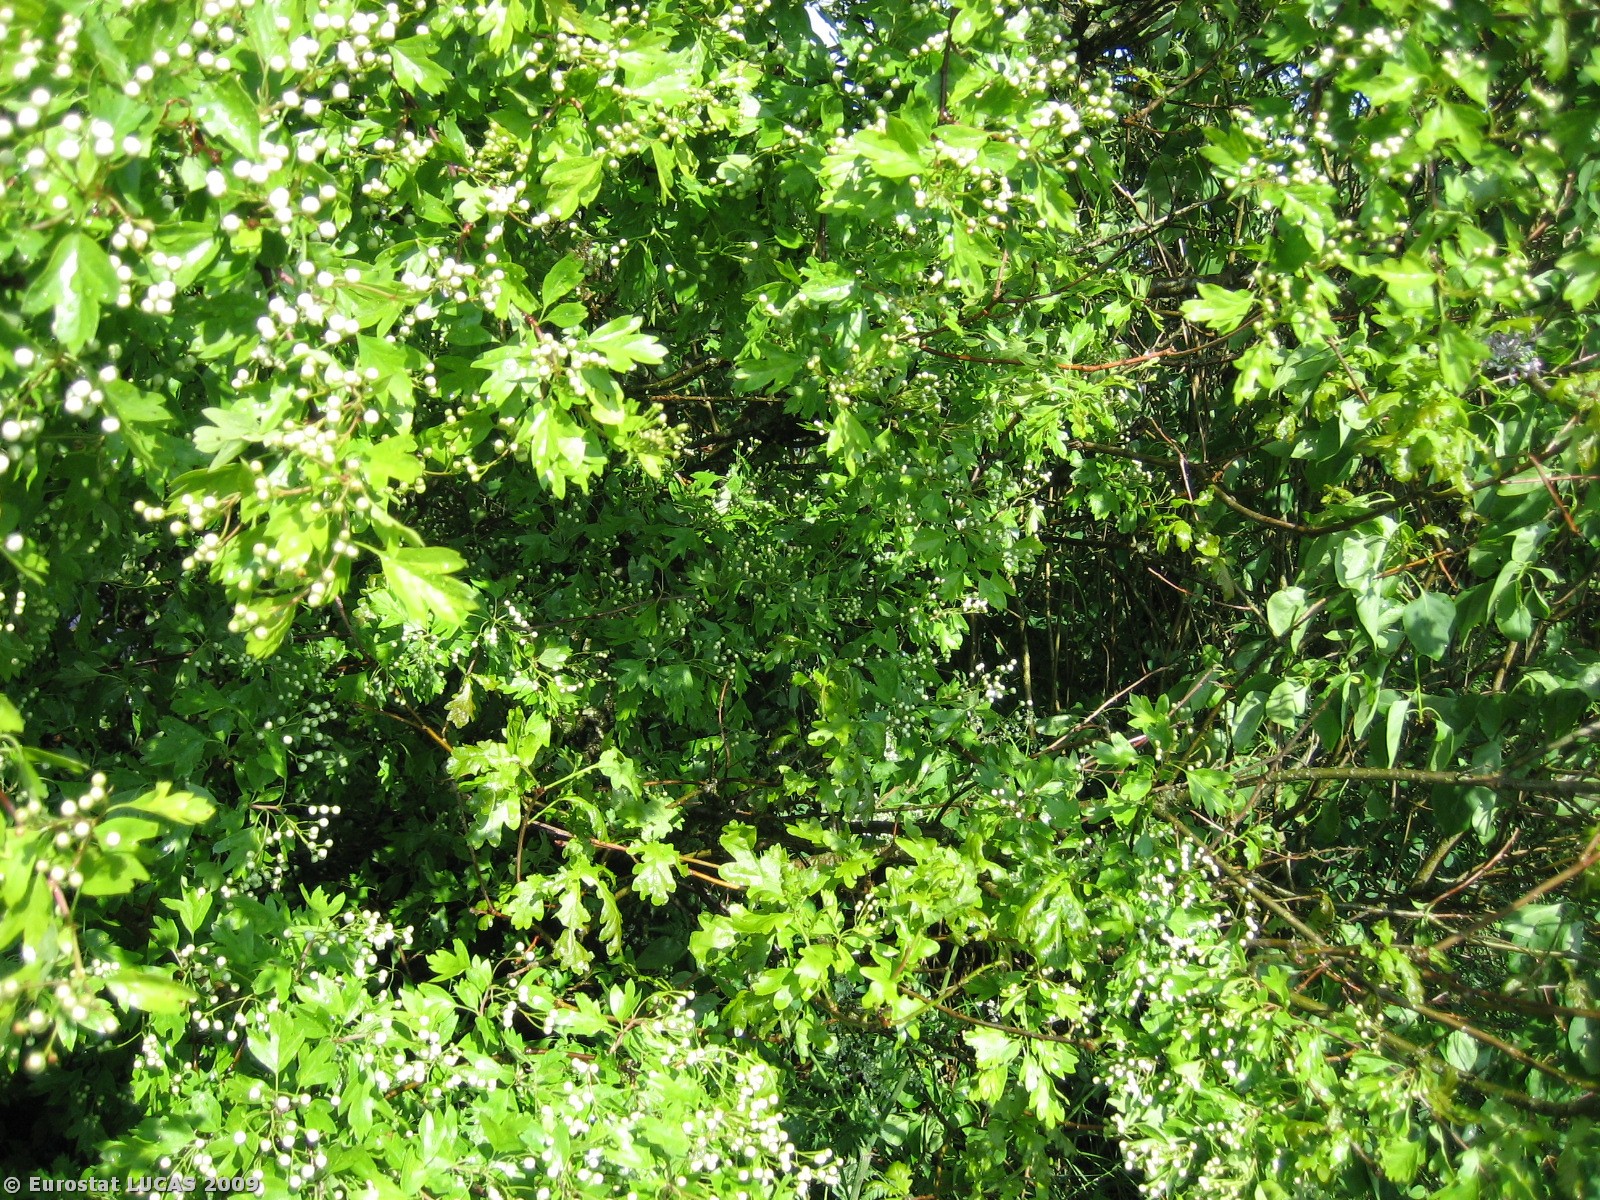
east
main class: Woodland
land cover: Broadleaved woodland
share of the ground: > 75 %
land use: Forestry
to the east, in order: Broadleaved woodland; Barley; Broadleaved woodland; Paved roads, cycling and walking lanes; Tracks; Shrubland without tree cover; Grassland without tree/shrub cover; Artificial constructions in urban areas; Grass margins; Common wheat; Broadleaved woodland
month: May
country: DK
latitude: 56.1638
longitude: 8.7615
